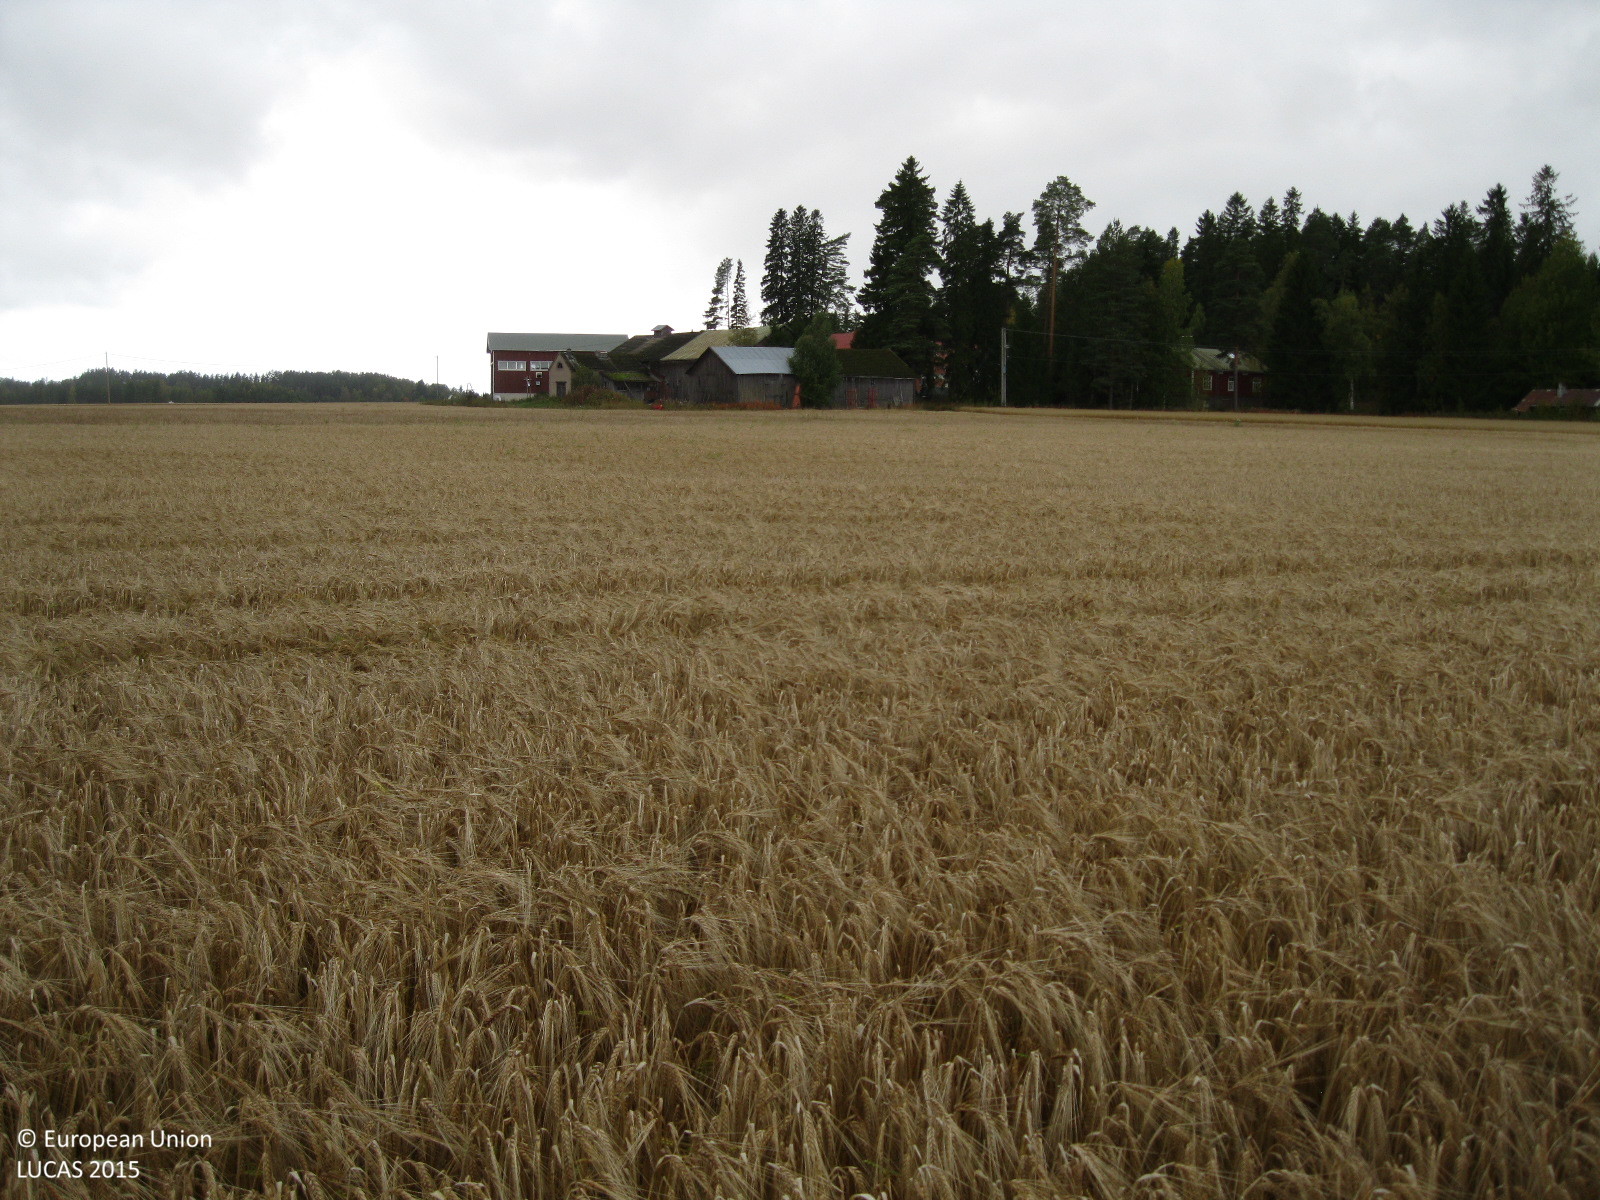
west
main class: Cropland
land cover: Barley
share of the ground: > 75 %
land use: Agriculture (excluding fallow land and kitchen gardens)
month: September
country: FI
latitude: 60.8224
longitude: 24.8404
